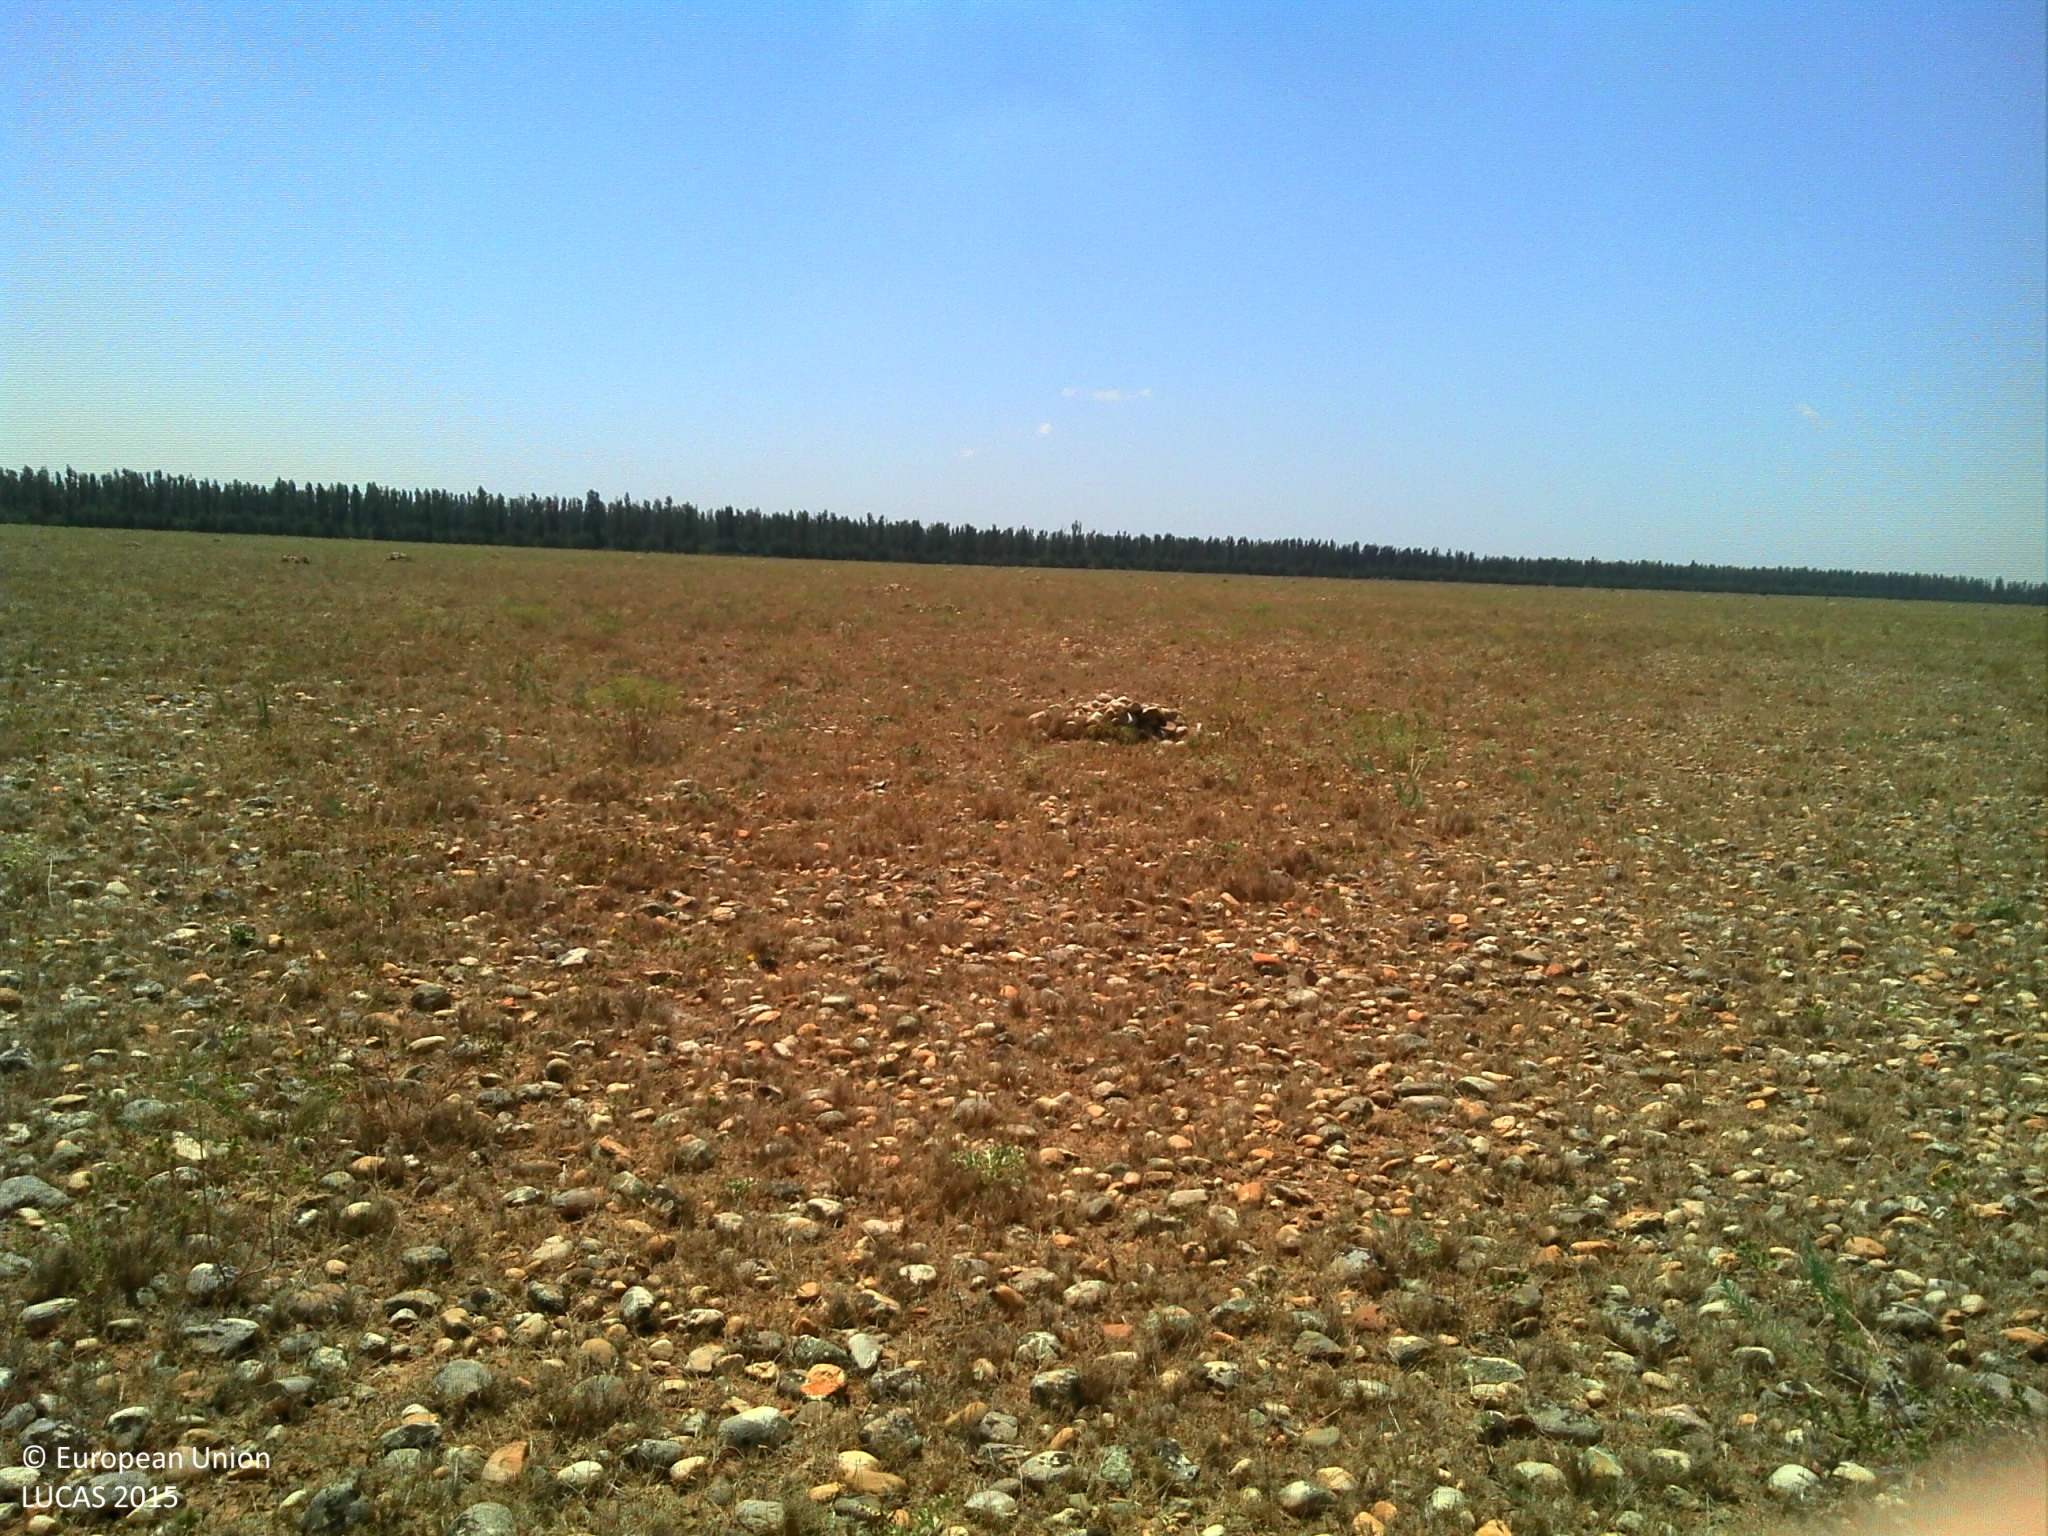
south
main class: Grassland
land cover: Spontaneously vegetated surfaces
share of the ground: 25 - 50 %
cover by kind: unconsolidated bare surface 45 %, herbaceous plants 30 %, consolidated bare surface 20 %, shrubs 5 %
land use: Agriculture (excluding fallow land and kitchen gardens)
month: July
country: FR
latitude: 43.5538
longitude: 4.8480
